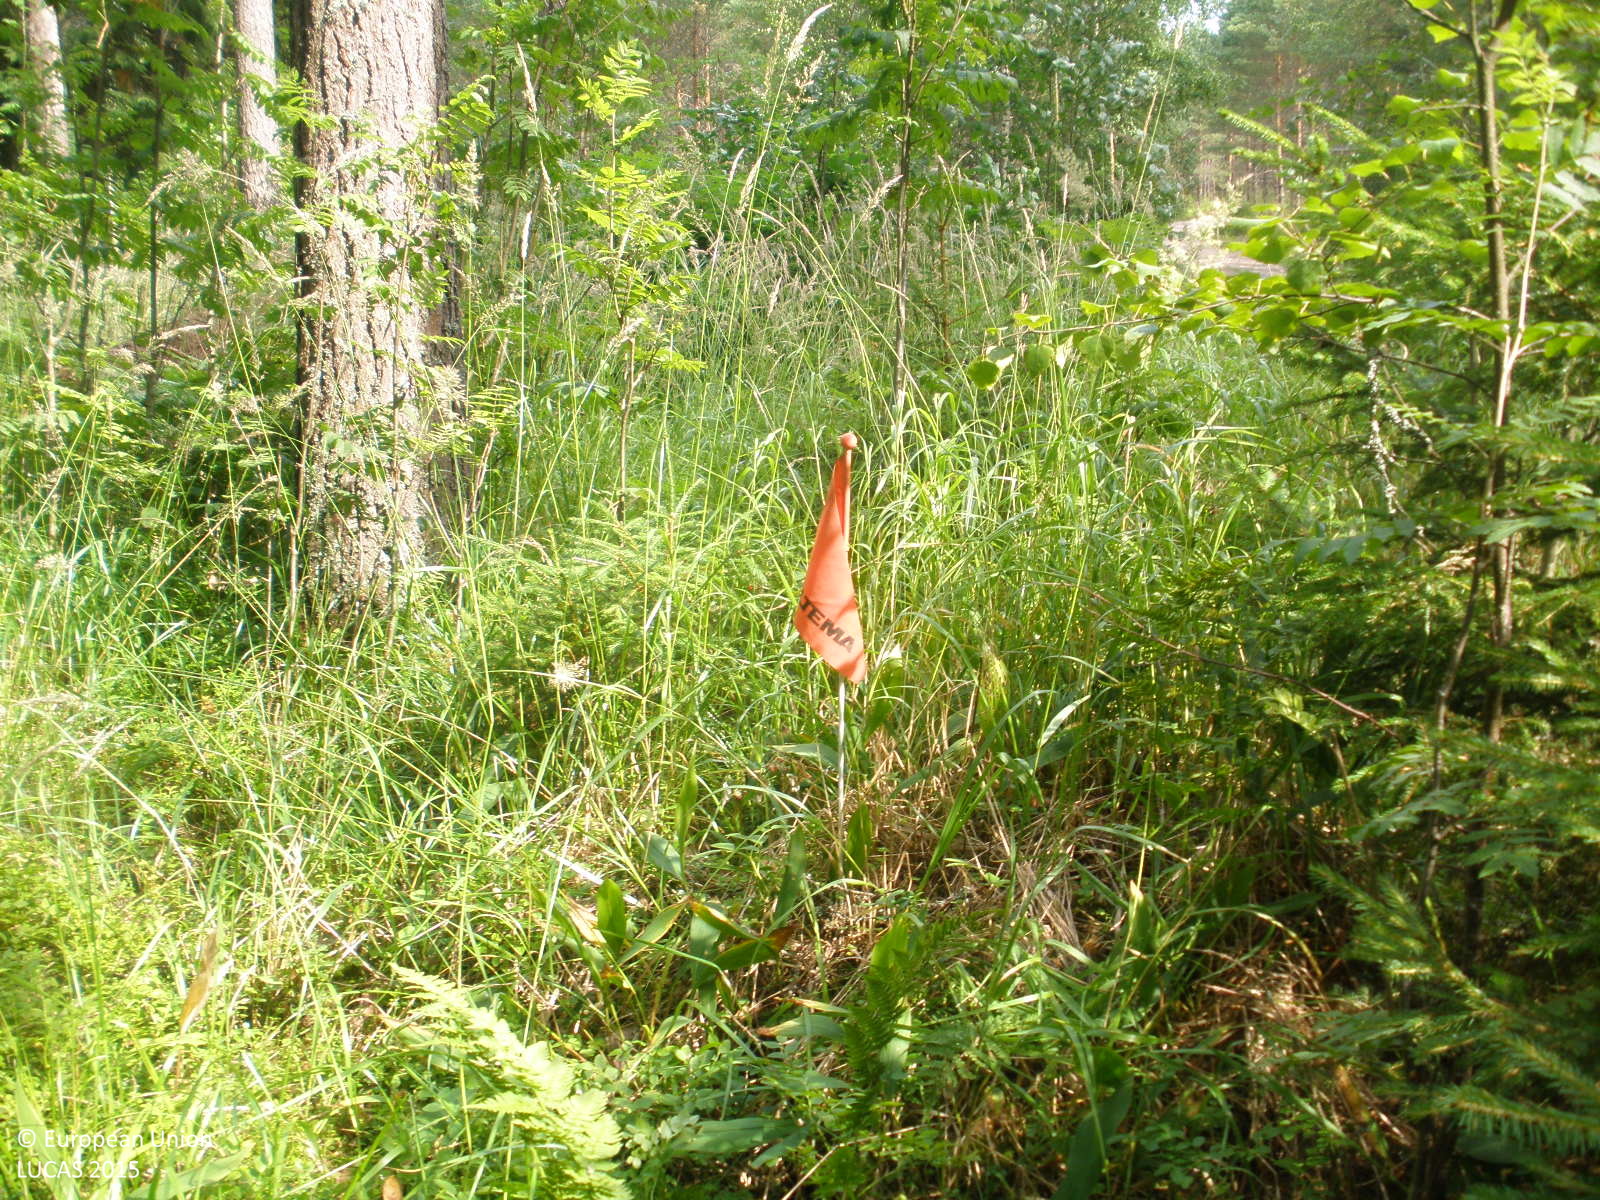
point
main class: Woodland
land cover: Other coniferous woodland
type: boreal forest
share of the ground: > 75 %
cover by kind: coniferous forest trees 85 %, herbaceous plants 10 %, lichens and mosses 5 %
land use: Forestry
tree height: > 5 m
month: August
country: FI
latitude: 60.8244
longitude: 24.4653
